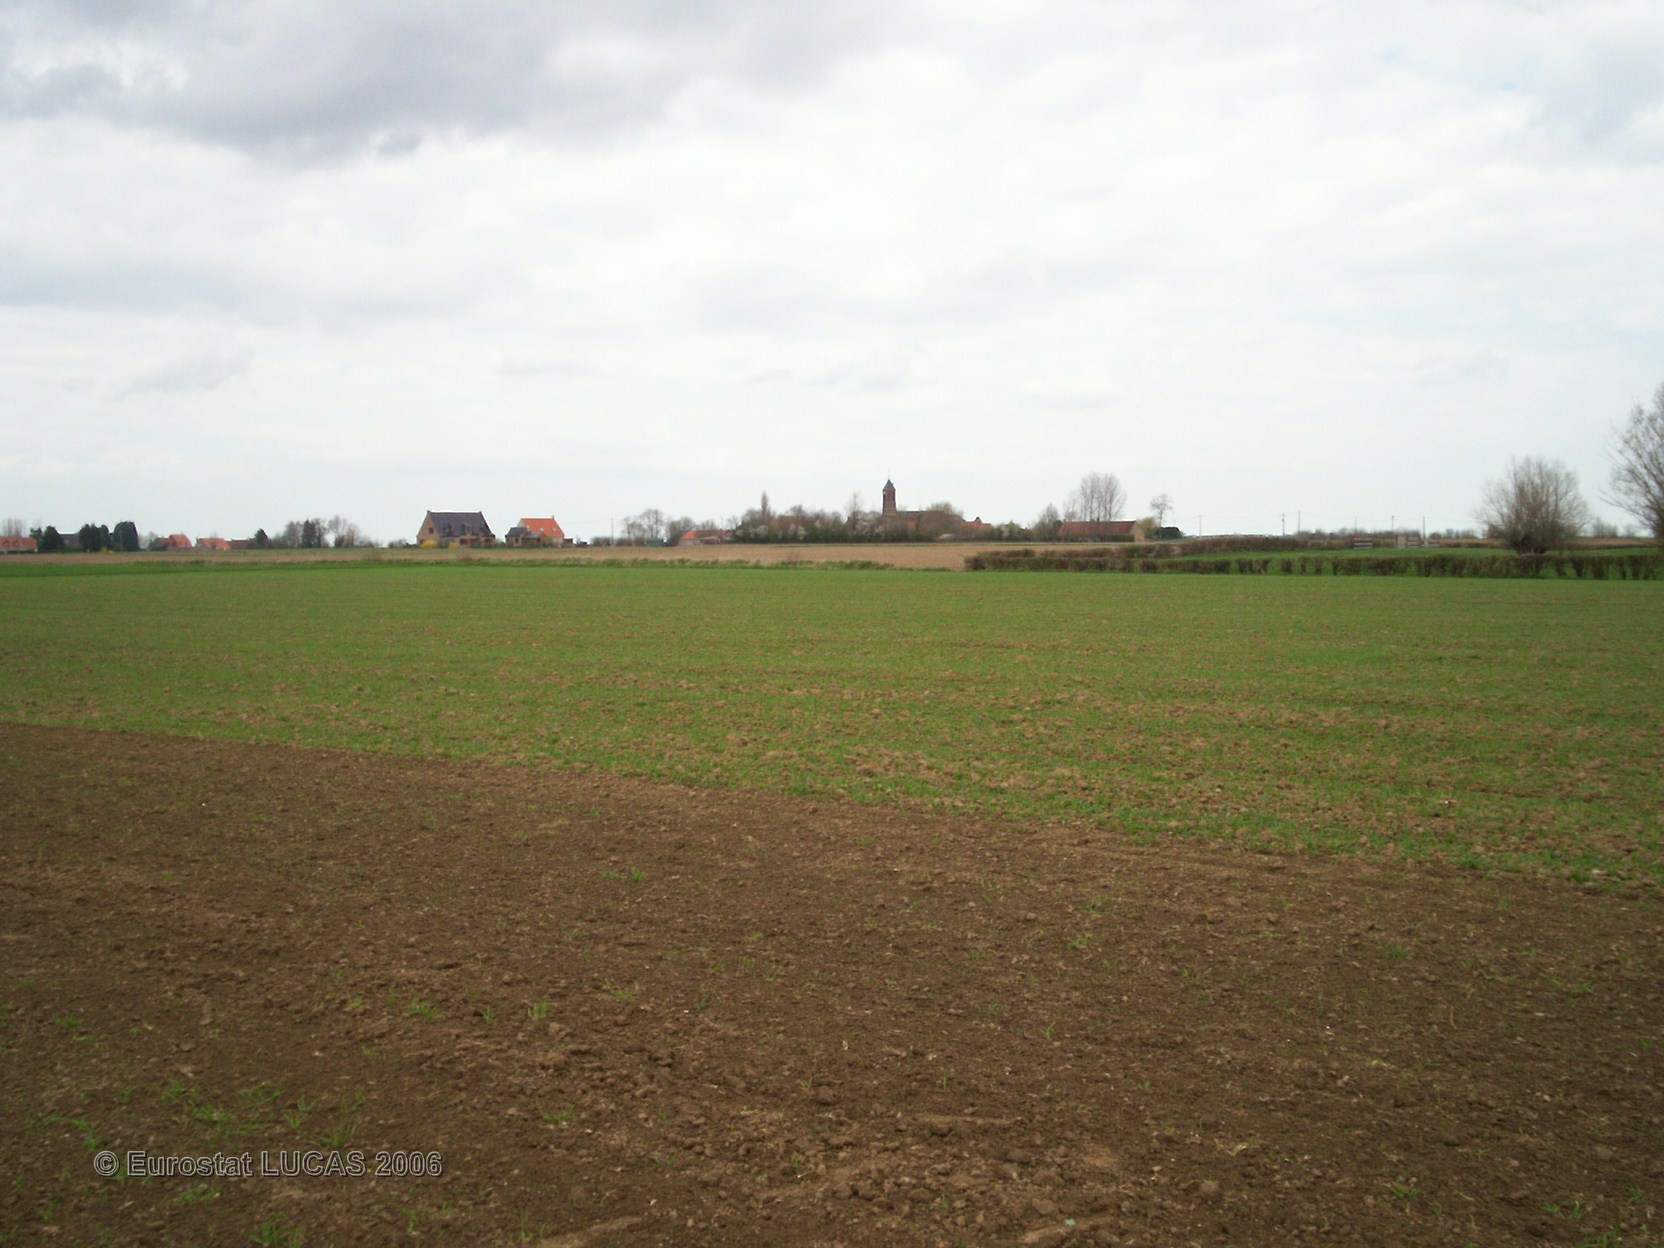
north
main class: Cropland
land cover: Common wheat
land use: Agriculture (excluding fallow land and kitchen gardens)
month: April
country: FR
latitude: 50.9062
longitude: 2.4069
